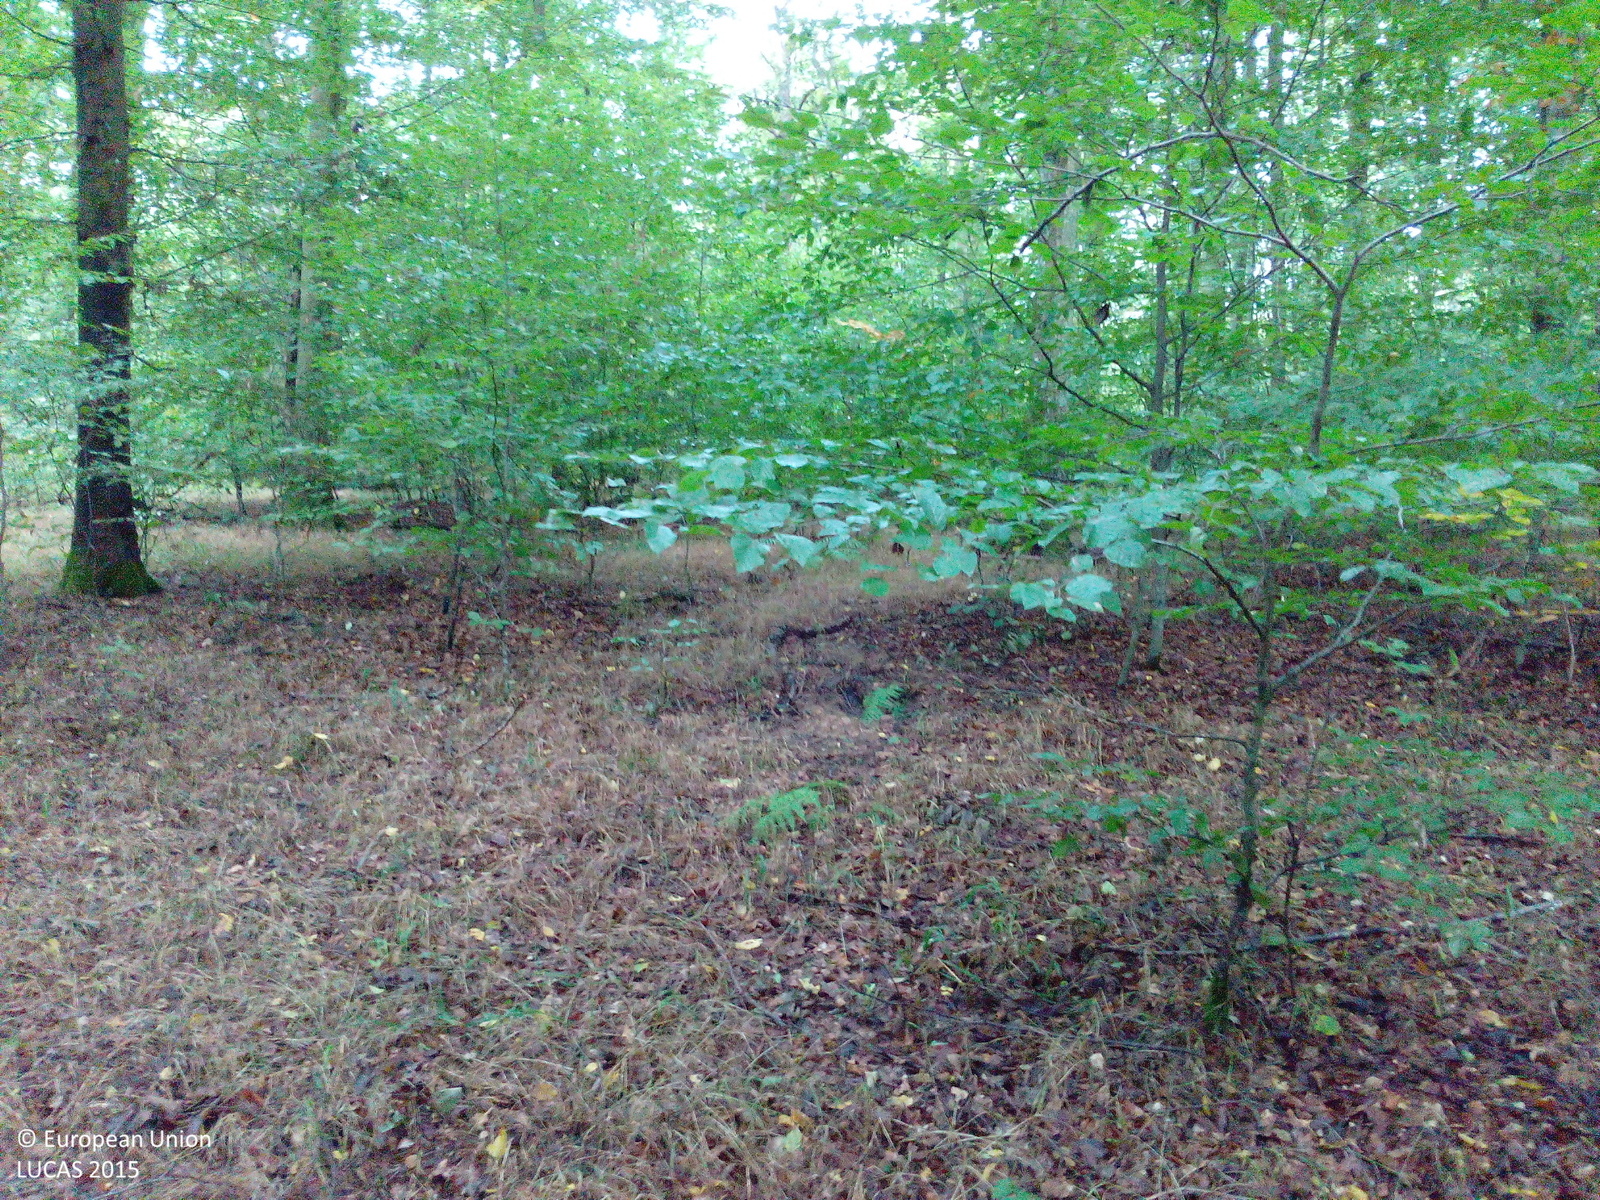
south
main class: Woodland
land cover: Broadleaved woodland
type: beech forest
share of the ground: > 75 %
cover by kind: broadleaved forest trees 95 %, herbaceous plants 5 %
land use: Forestry
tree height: > 5 m
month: September
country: DE
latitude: 49.9145
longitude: 9.9582
